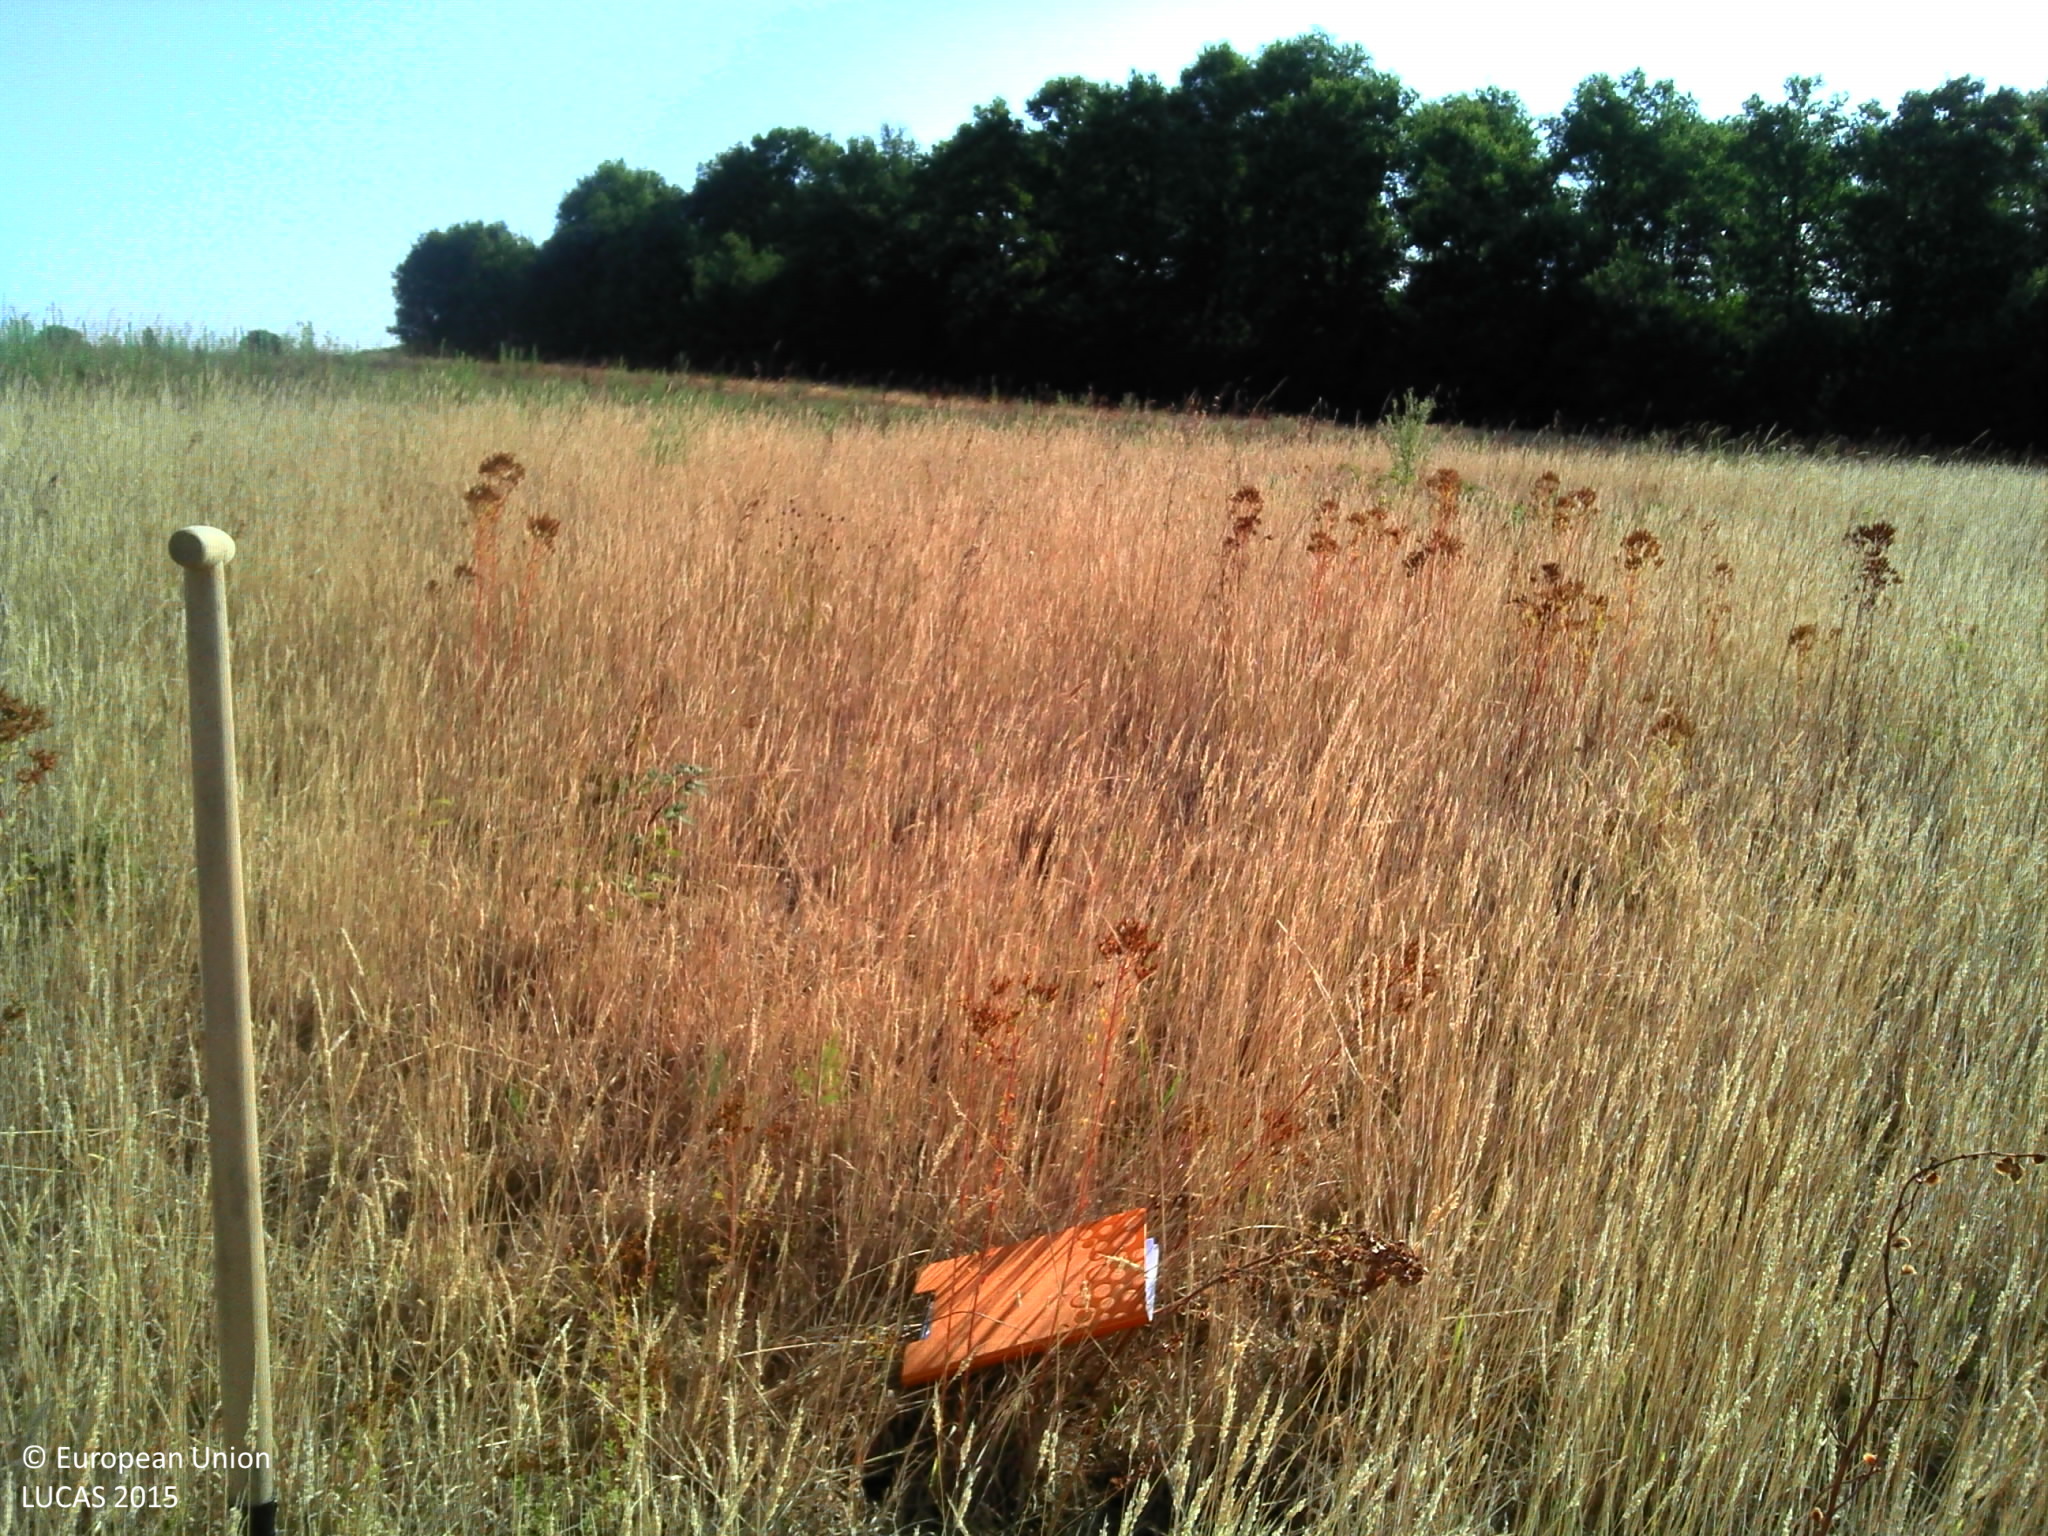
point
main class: Grassland
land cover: Grassland without tree/shrub cover
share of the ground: > 75 %
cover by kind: herbaceous plants 100 %
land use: Agriculture (excluding fallow land and kitchen gardens)
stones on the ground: 10 - 25 %
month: July
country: FR
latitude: 47.0739
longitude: 2.1293
